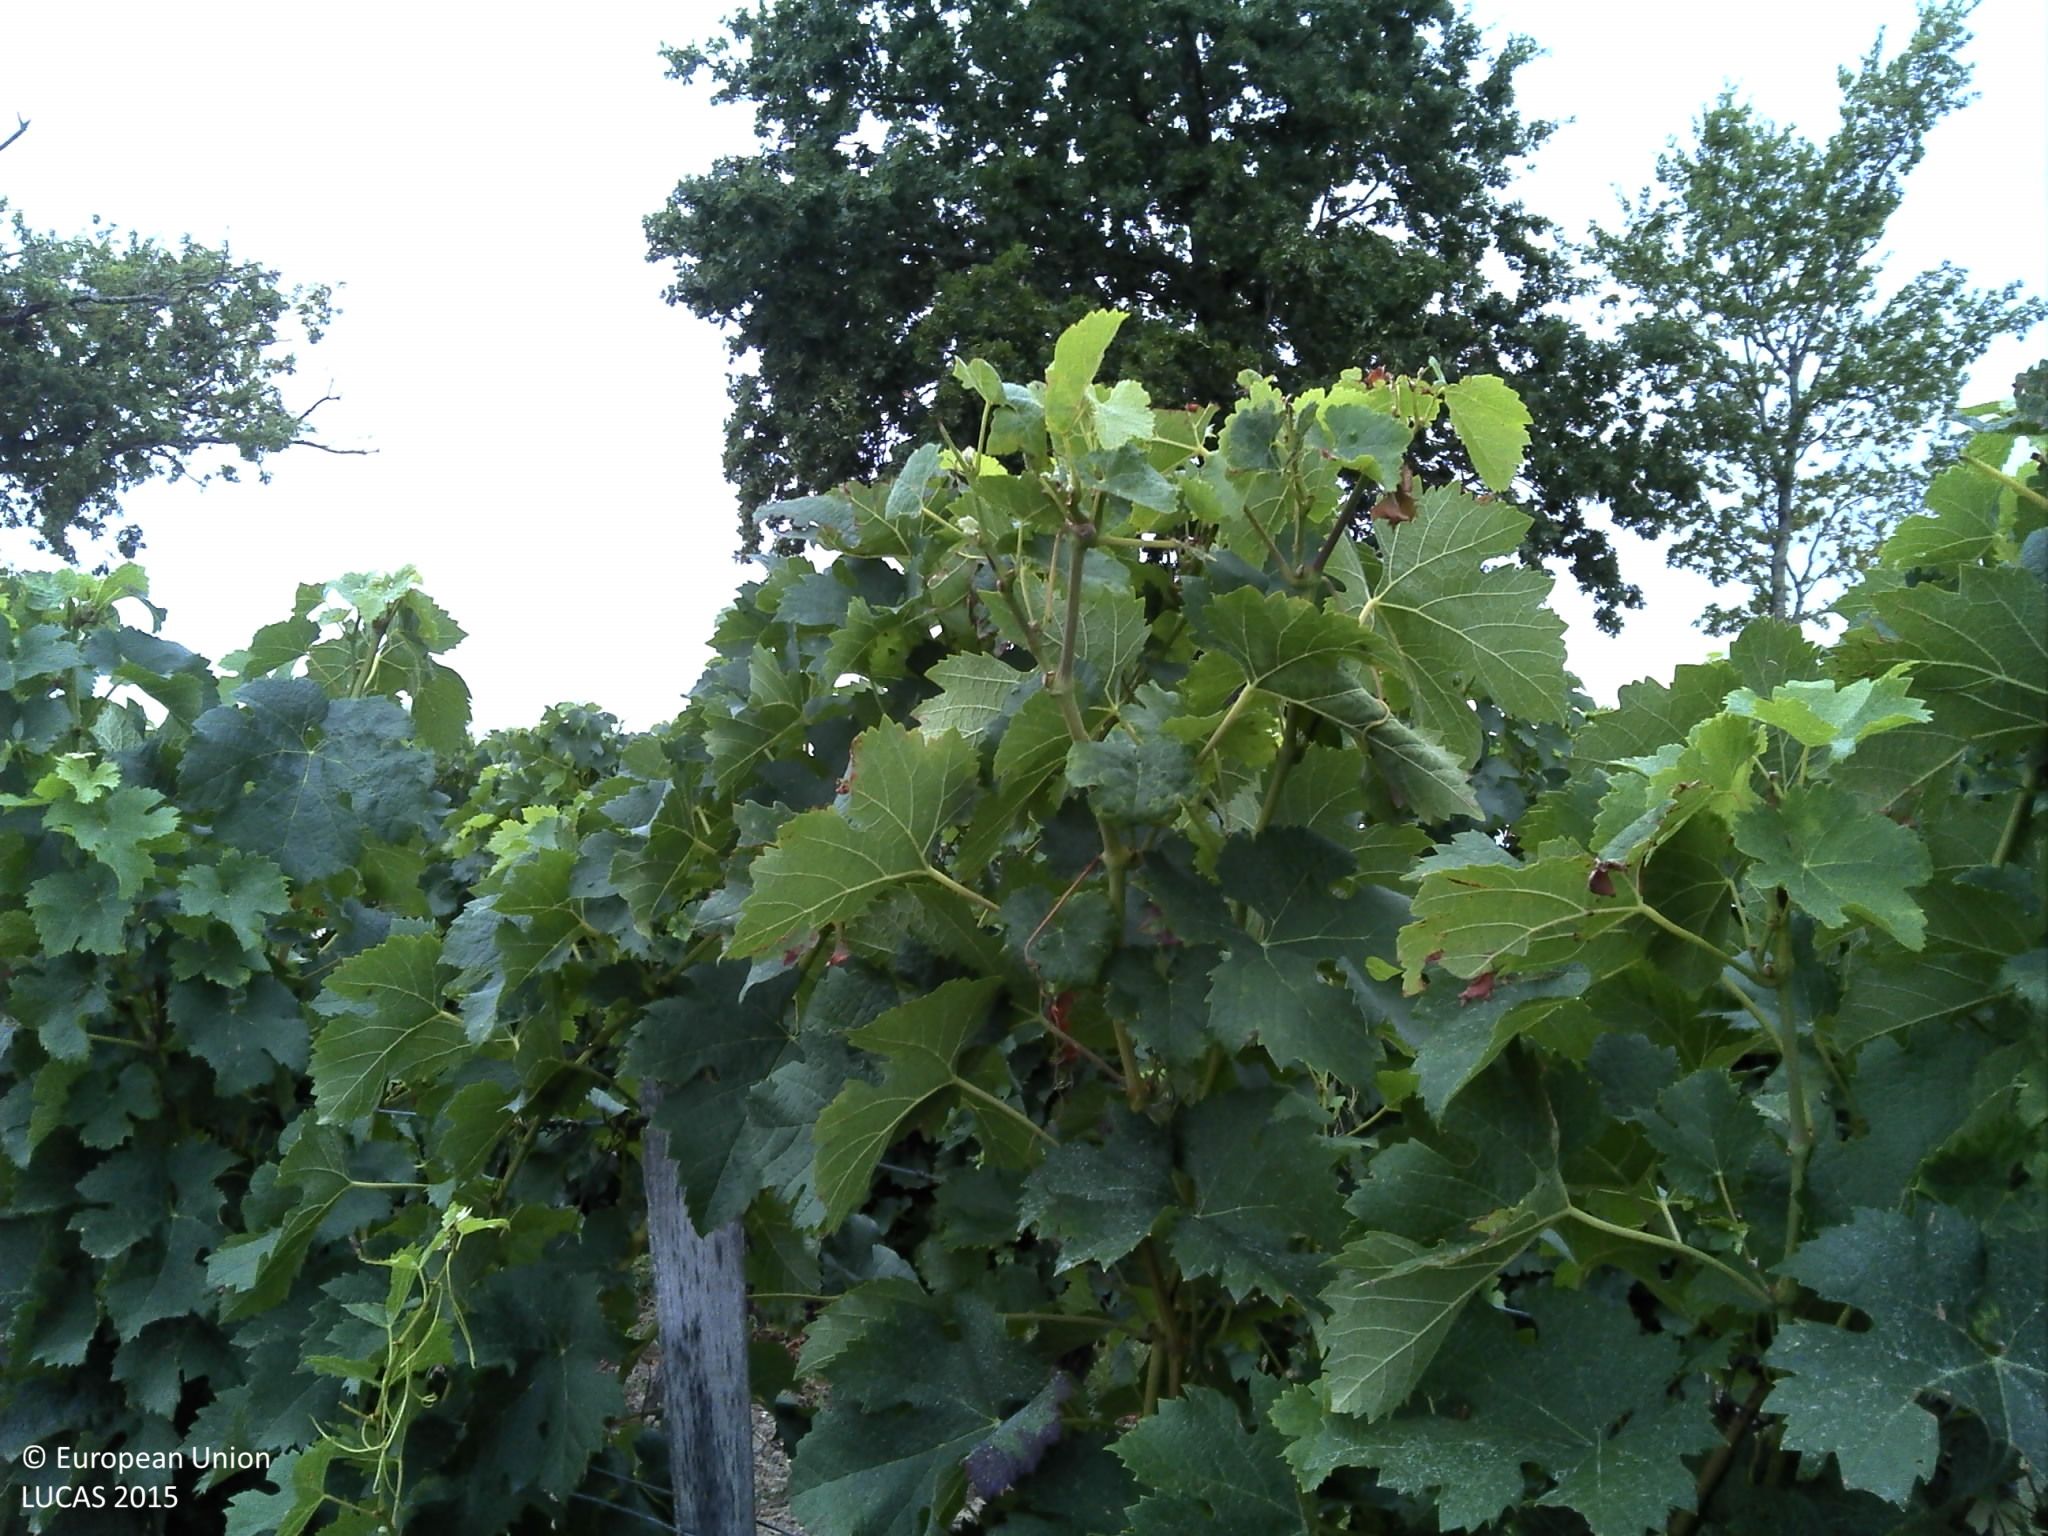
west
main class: Cropland
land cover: Vineyards
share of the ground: 25 - 50 %
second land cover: Grassland without tree/shrub cover
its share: > 75 %
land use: Agriculture (excluding fallow land and kitchen gardens)
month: August
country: FR
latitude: 45.1035
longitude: -0.5298
